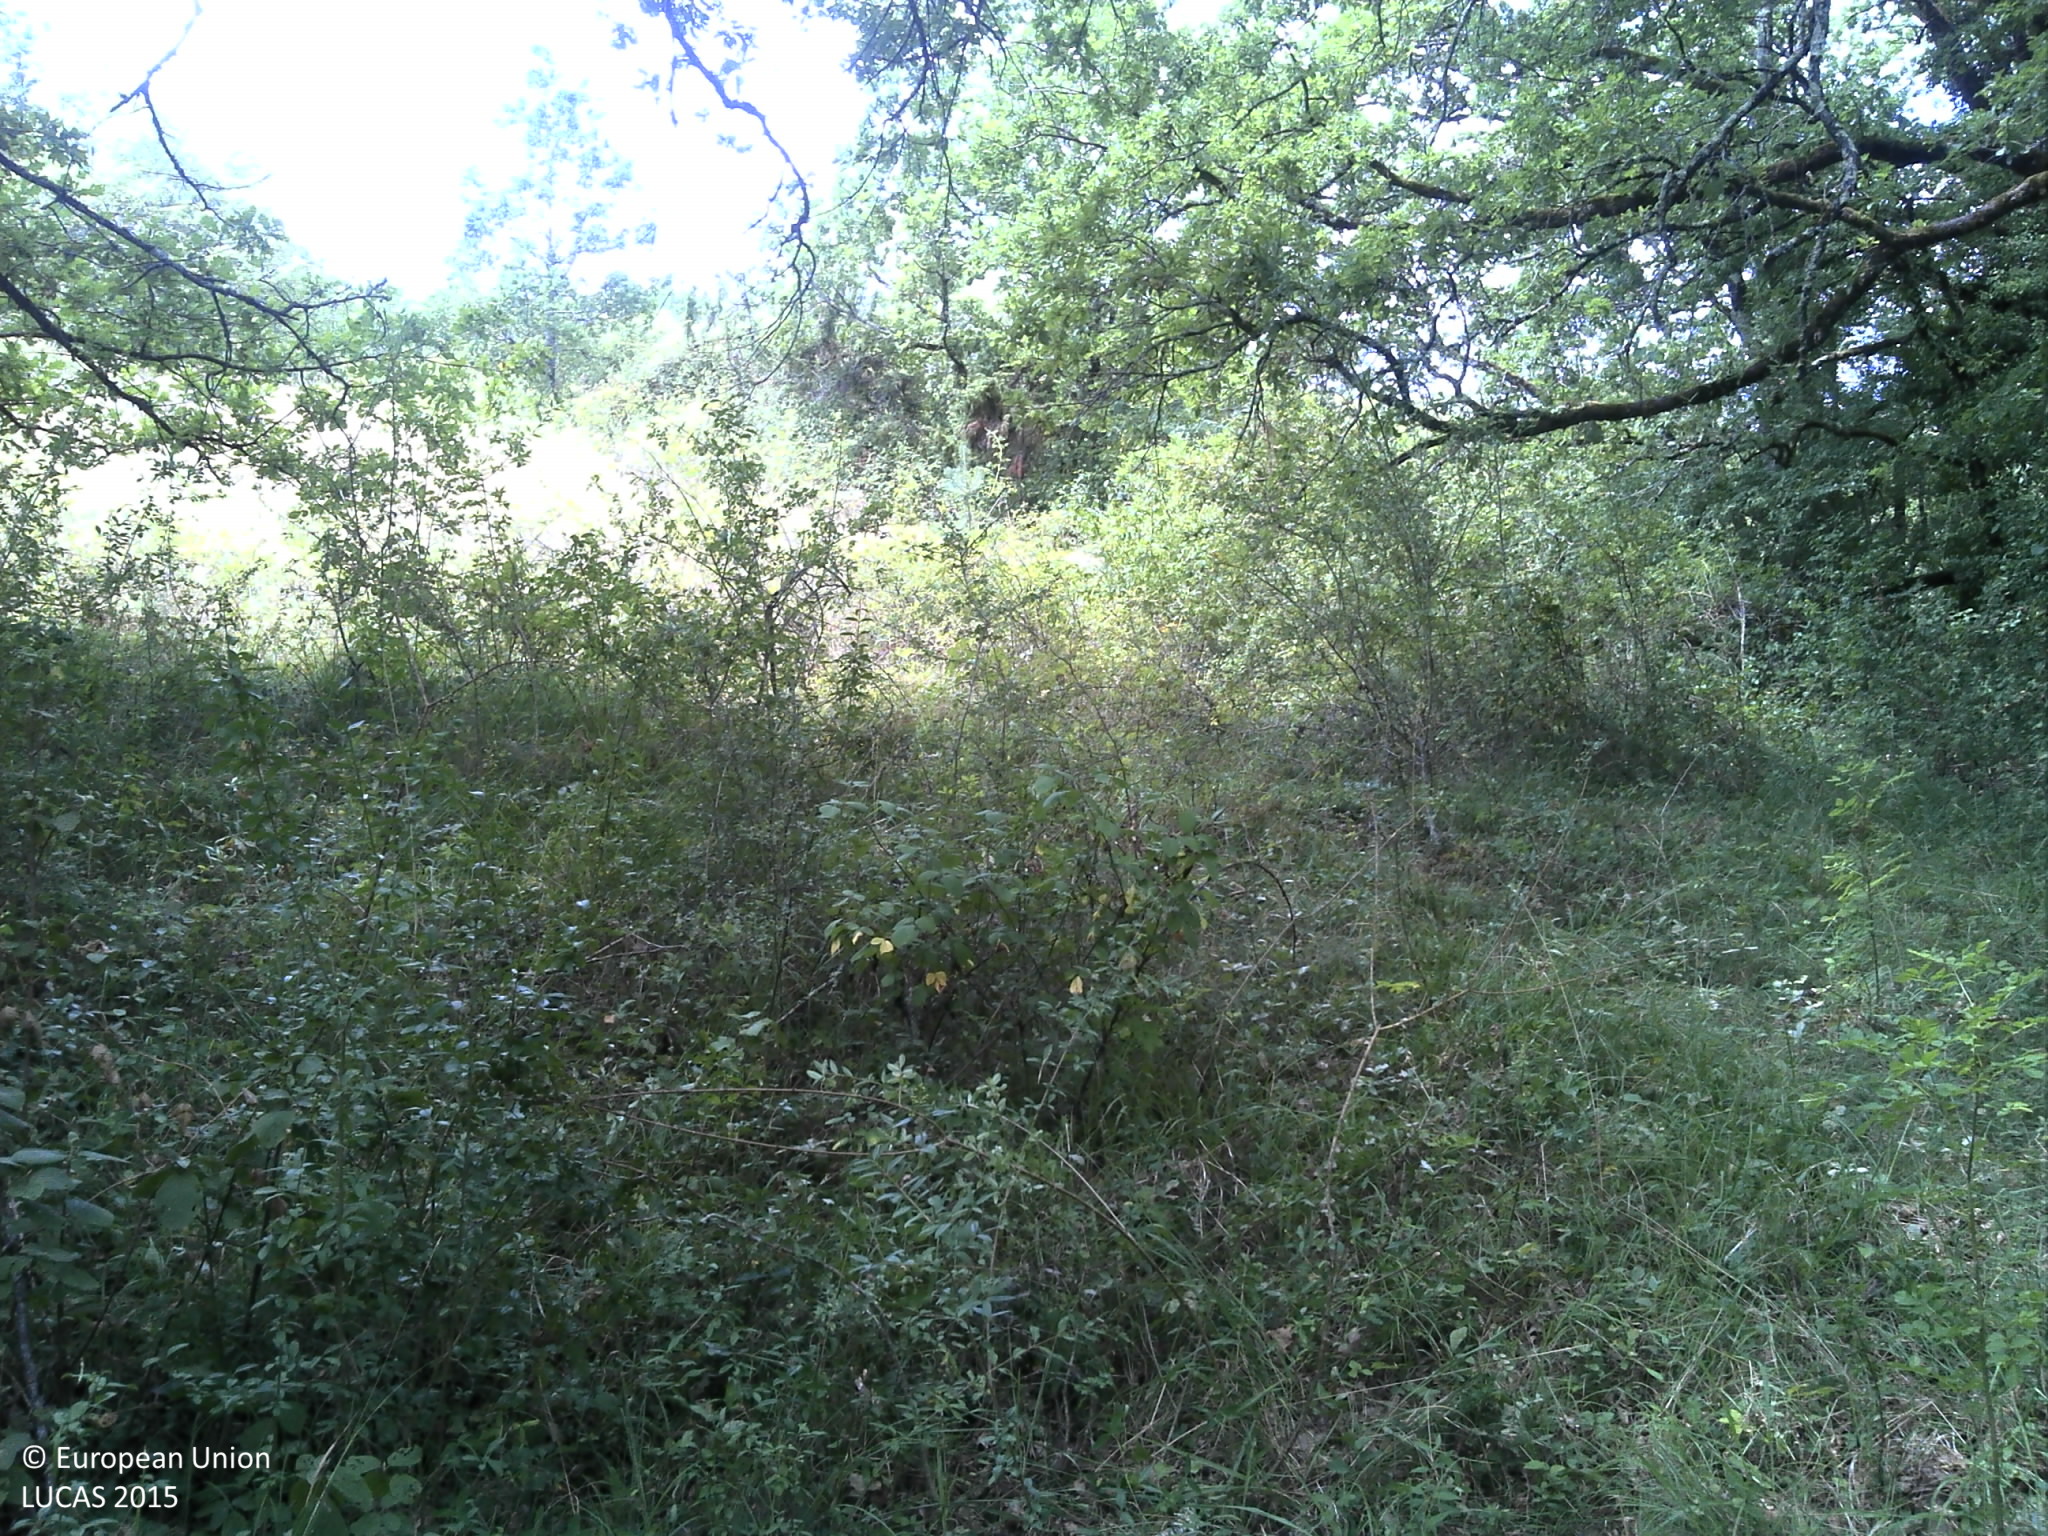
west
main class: Woodland
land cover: Broadleaved woodland
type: mesophytic deciduous forest
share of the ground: 50 - 75 %
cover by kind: broadleaved forest trees 55 %, herbaceous plants 35 %, shrubs 5 %, lichens and mosses 5 %
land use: Forestry
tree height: > 5 m
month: July
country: FR
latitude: 44.9474
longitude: 1.7719
